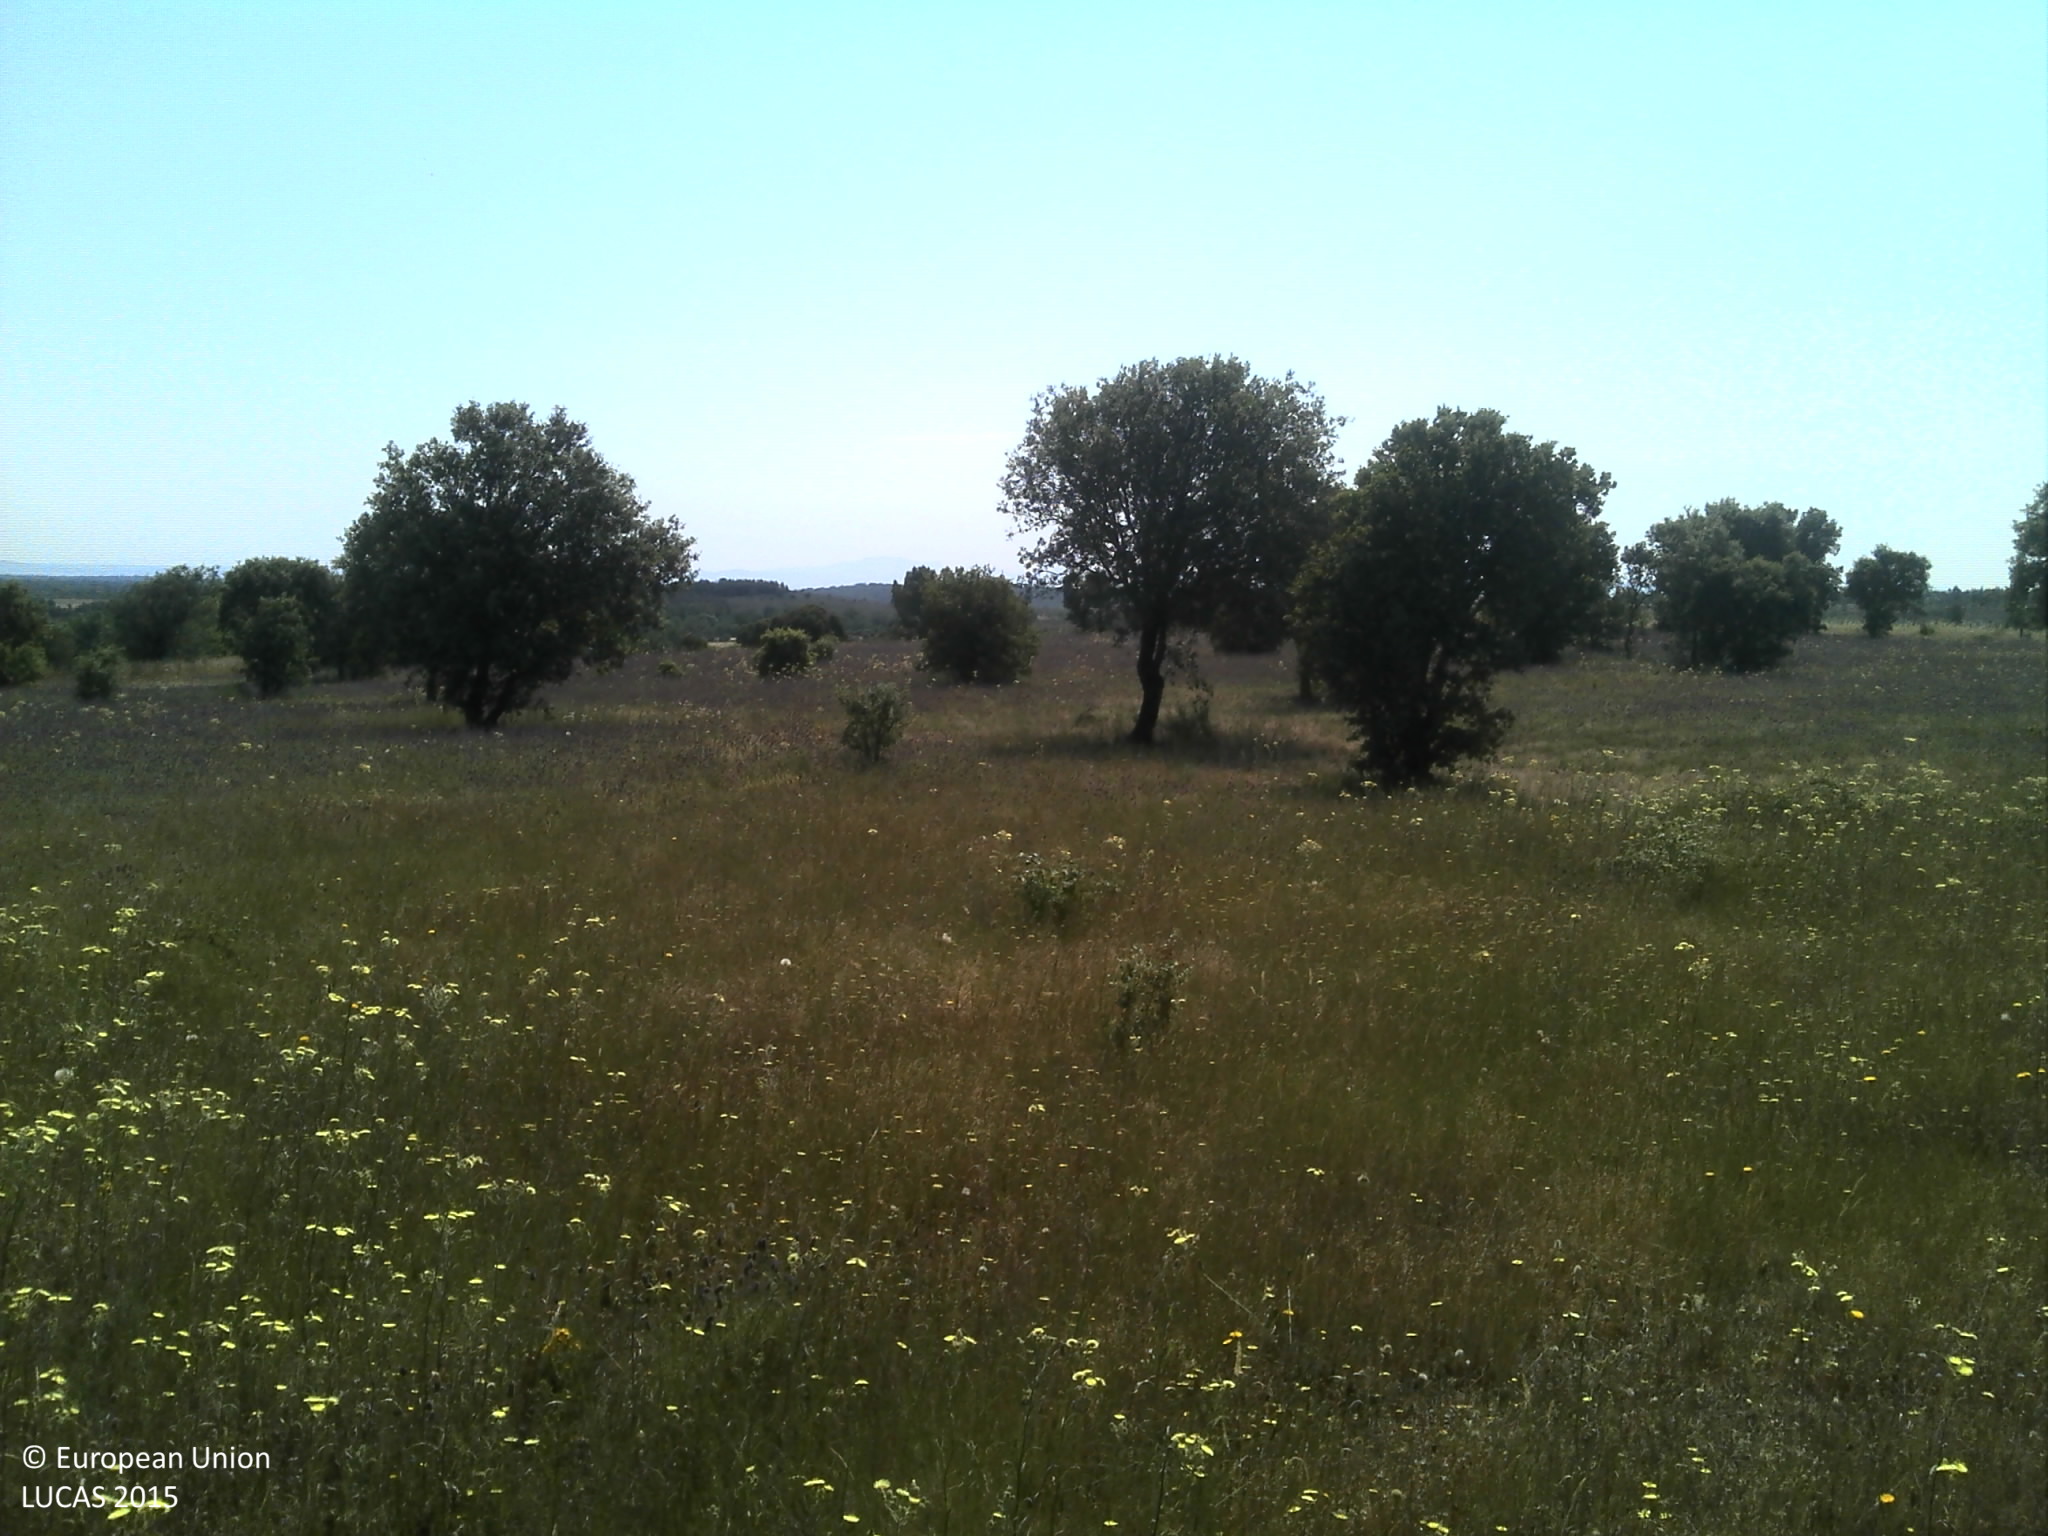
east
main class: Grassland
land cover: Grassland with sparse tree/shrub cover
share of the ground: 50 - 75 %
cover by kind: herbaceous plants 60 %, unconsolidated bare surface 30 %, broadleaved forest trees 5 %
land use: Agriculture (excluding fallow land and kitchen gardens)
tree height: > 5 m
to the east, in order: Grassland with sparse tree/shrub cover; Fences; Grassland with sparse tree/shrub cover; Shrubland with sparse tree cover
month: June
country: PT
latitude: 40.5310
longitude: -6.8474
